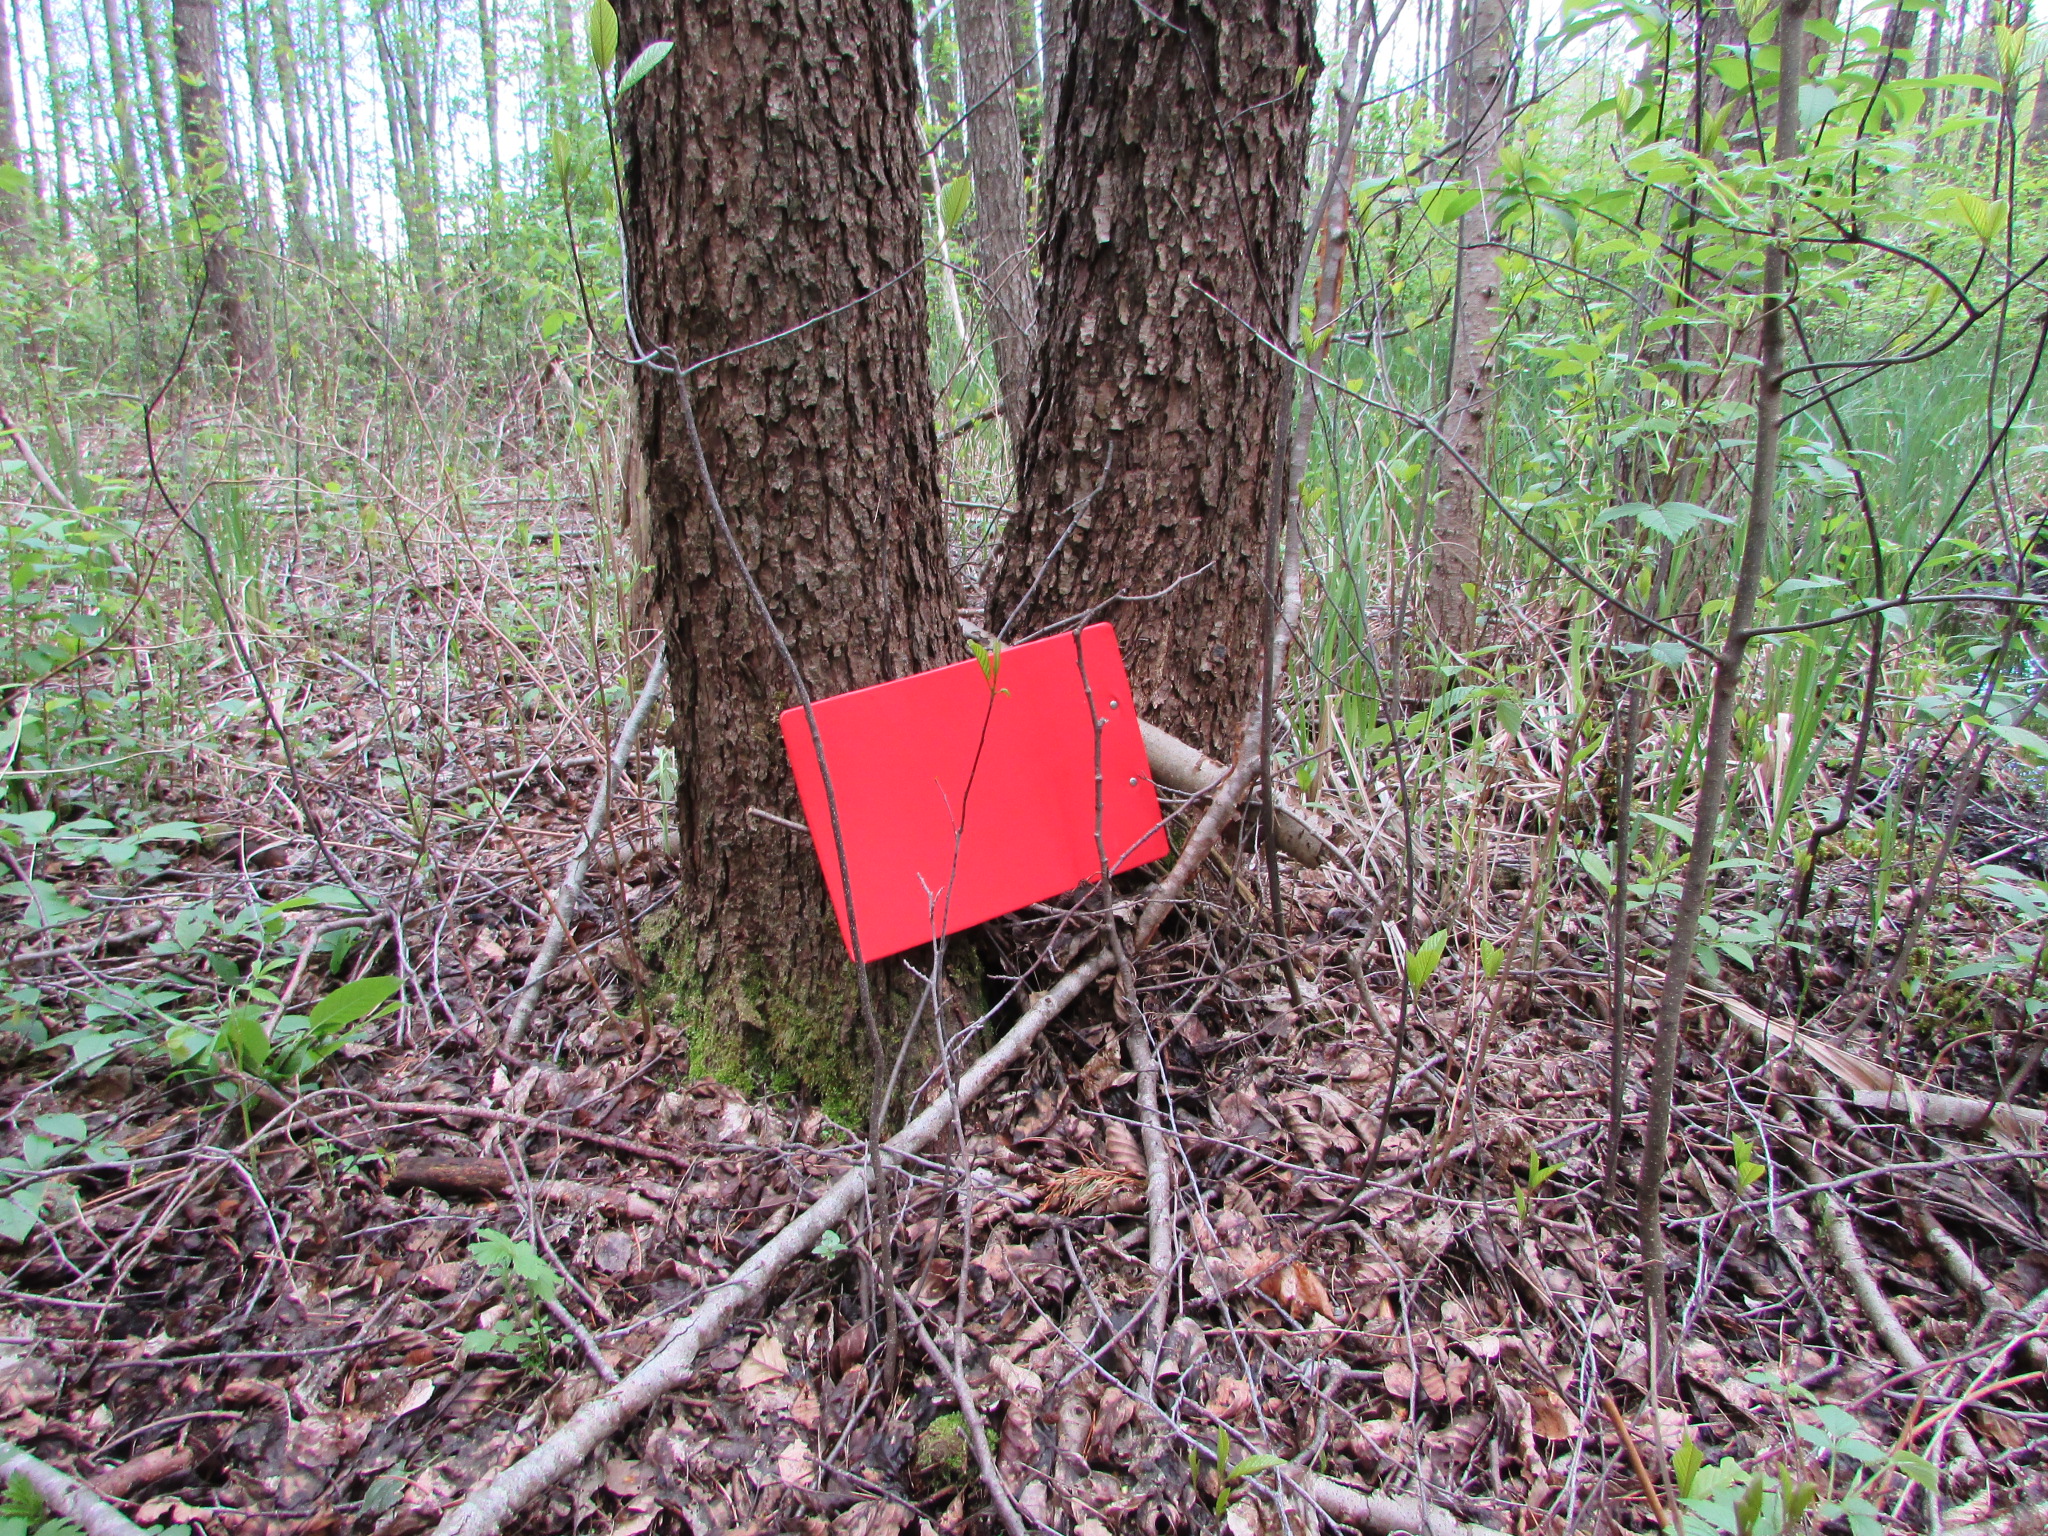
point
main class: Woodland
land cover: Pine dominated mixed woodland
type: hemiboreal forest and nemoral coniferous forest and mixed broadleaved-coniferous forest
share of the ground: > 75 %
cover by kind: coniferous forest trees 70 %, broadleaved forest trees 30 %
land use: Forestry
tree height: > 5 m
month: May
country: LV
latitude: 56.1273
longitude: 27.2749
